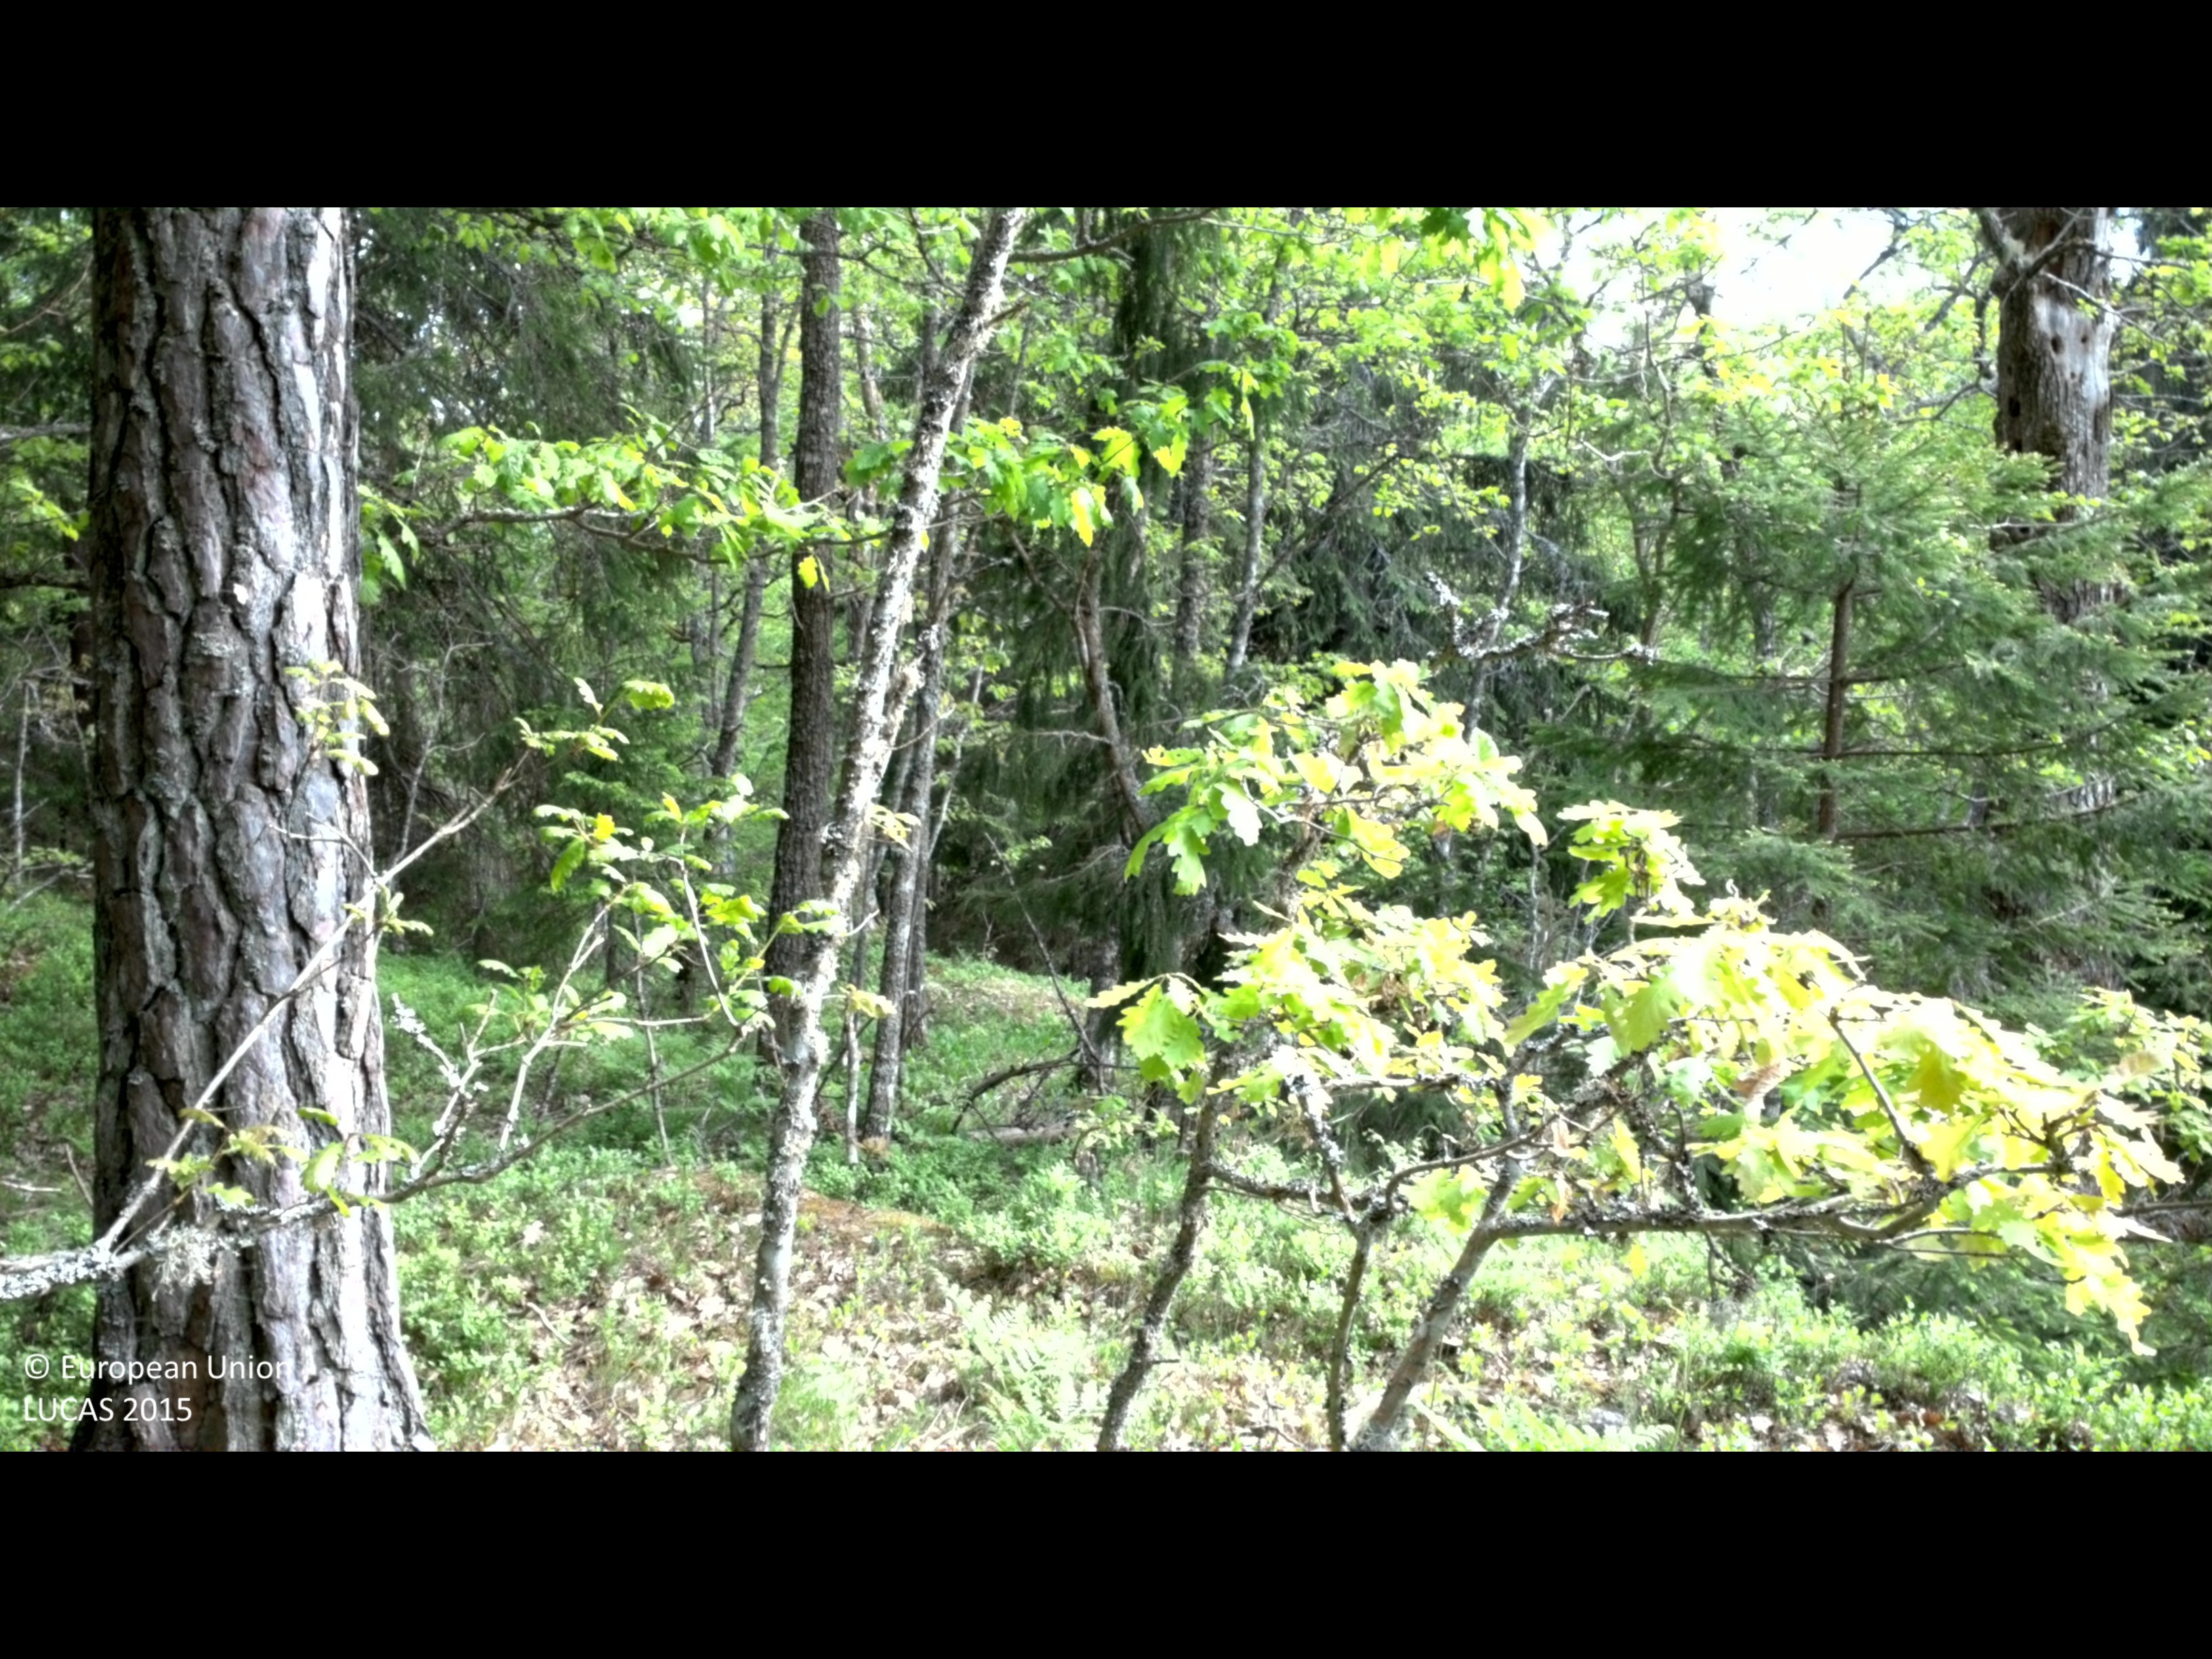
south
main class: Woodland
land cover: Spruce dominated mixed woodland
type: boreal forest
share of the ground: > 75 %
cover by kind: coniferous forest trees 45 %, broadleaved forest trees 40 %, shrubs 10 %, consolidated bare surface 5 %
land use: Forestry
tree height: > 5 m
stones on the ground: 10 - 25 %
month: May
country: SE
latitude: 57.4852
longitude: 16.4879
